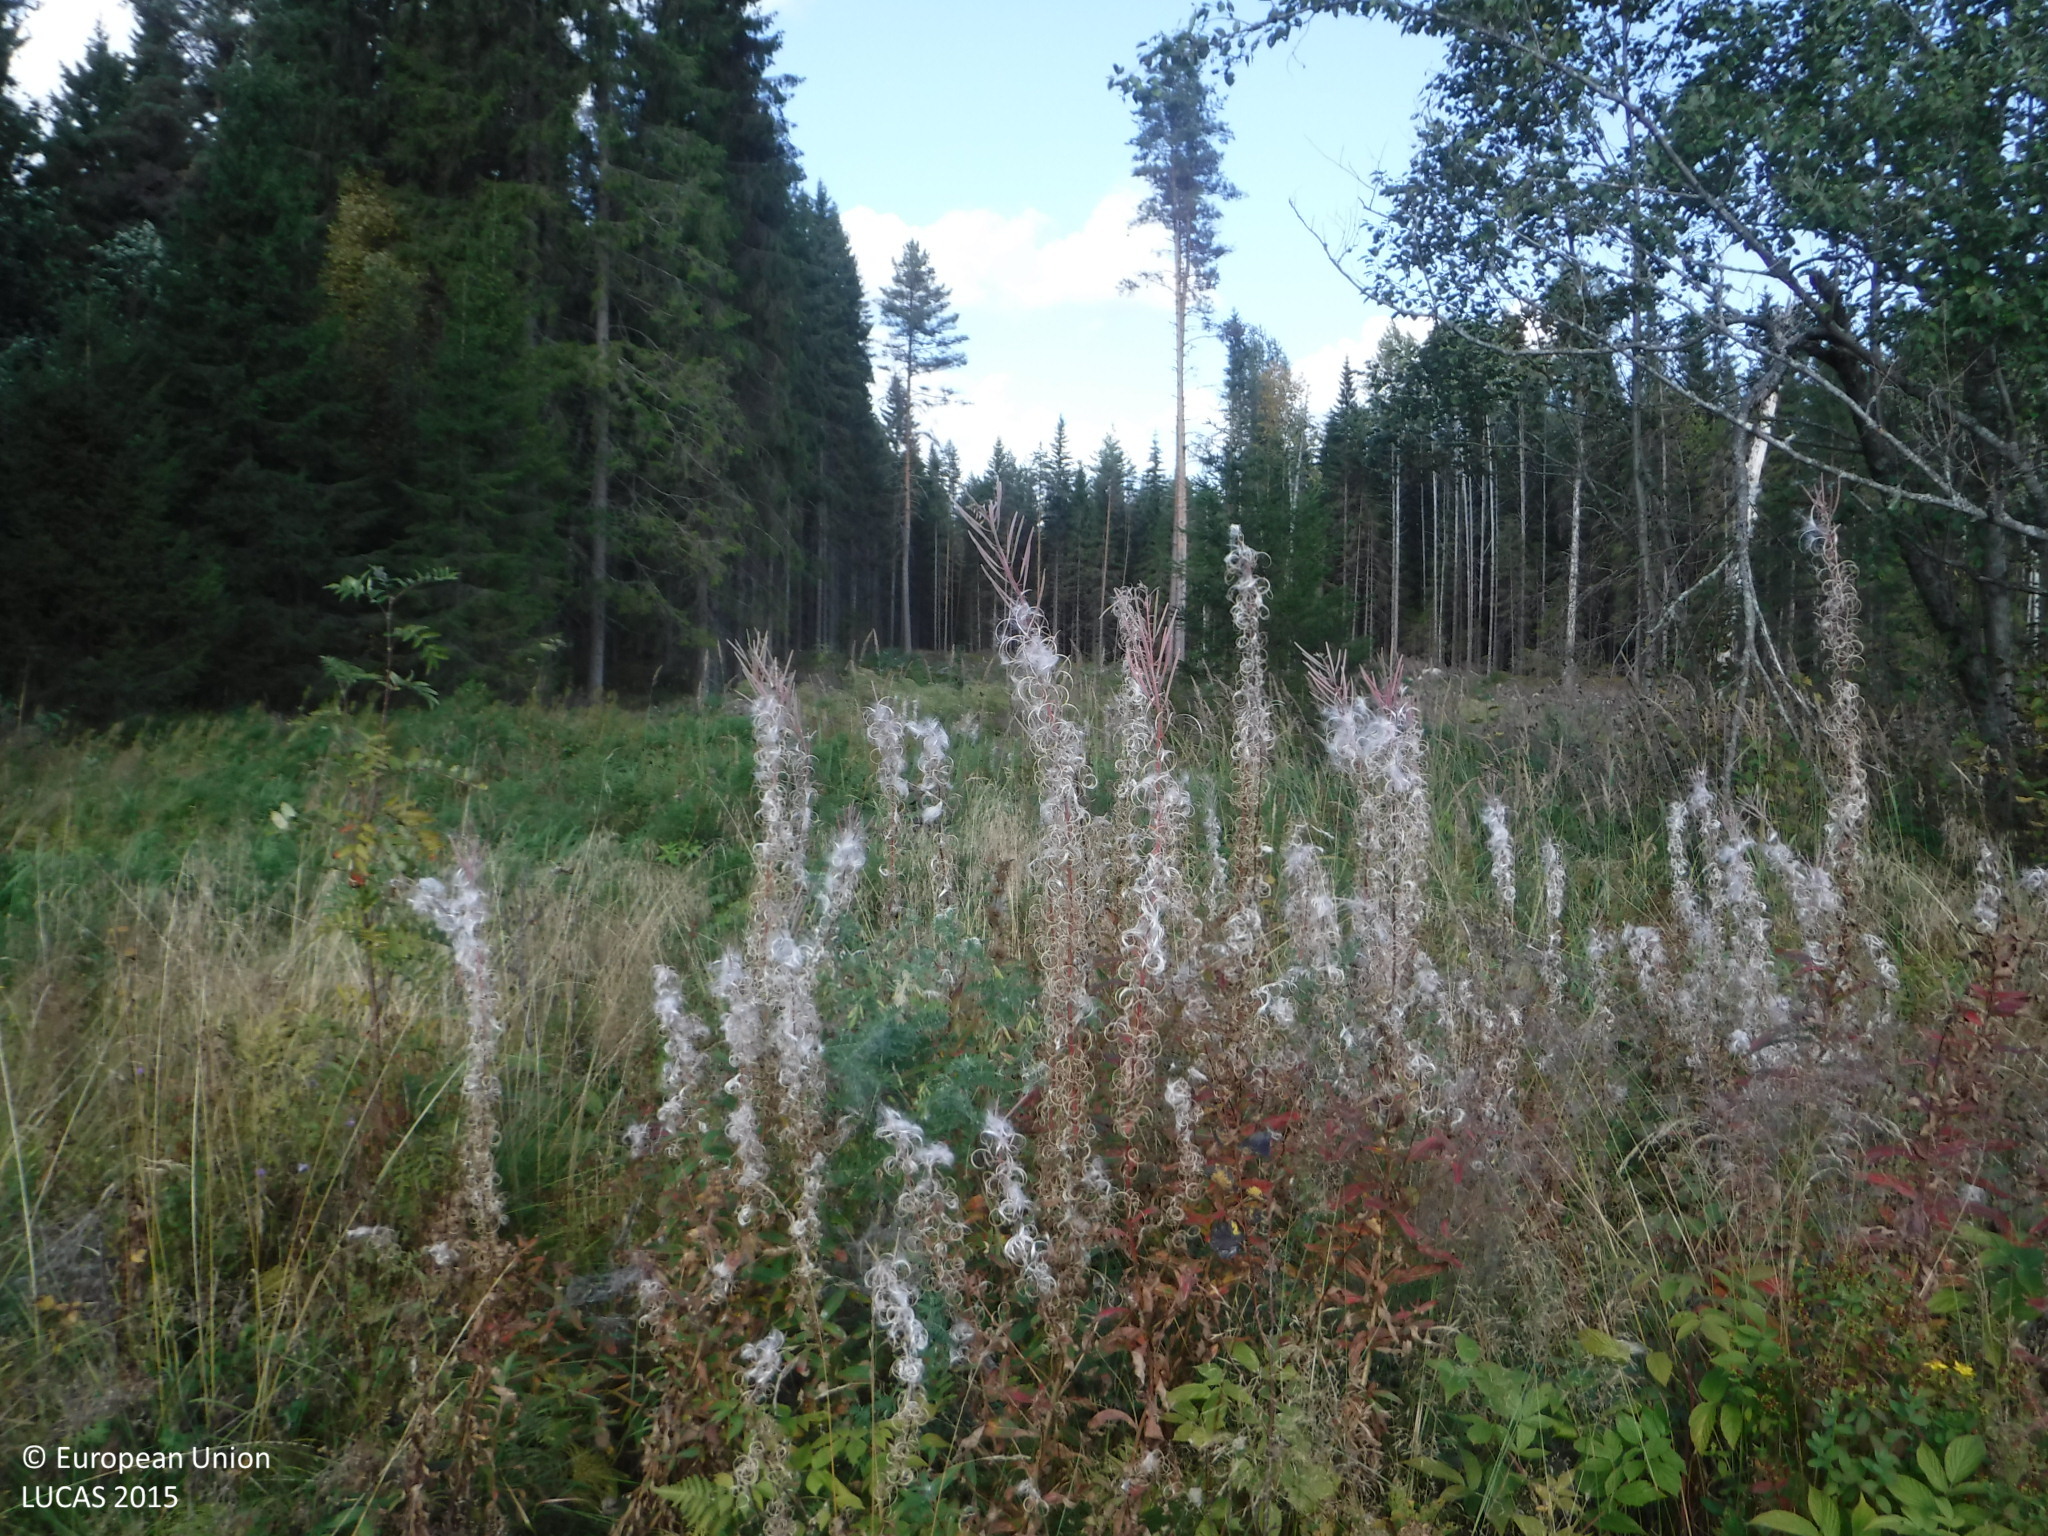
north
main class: Grassland
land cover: Grassland with sparse tree/shrub cover
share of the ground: > 75 %
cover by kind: herbaceous plants 95 %, broadleaved forest trees 5 %
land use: Forestry
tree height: < 5 m
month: September
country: FI
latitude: 61.6666
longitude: 22.0880
